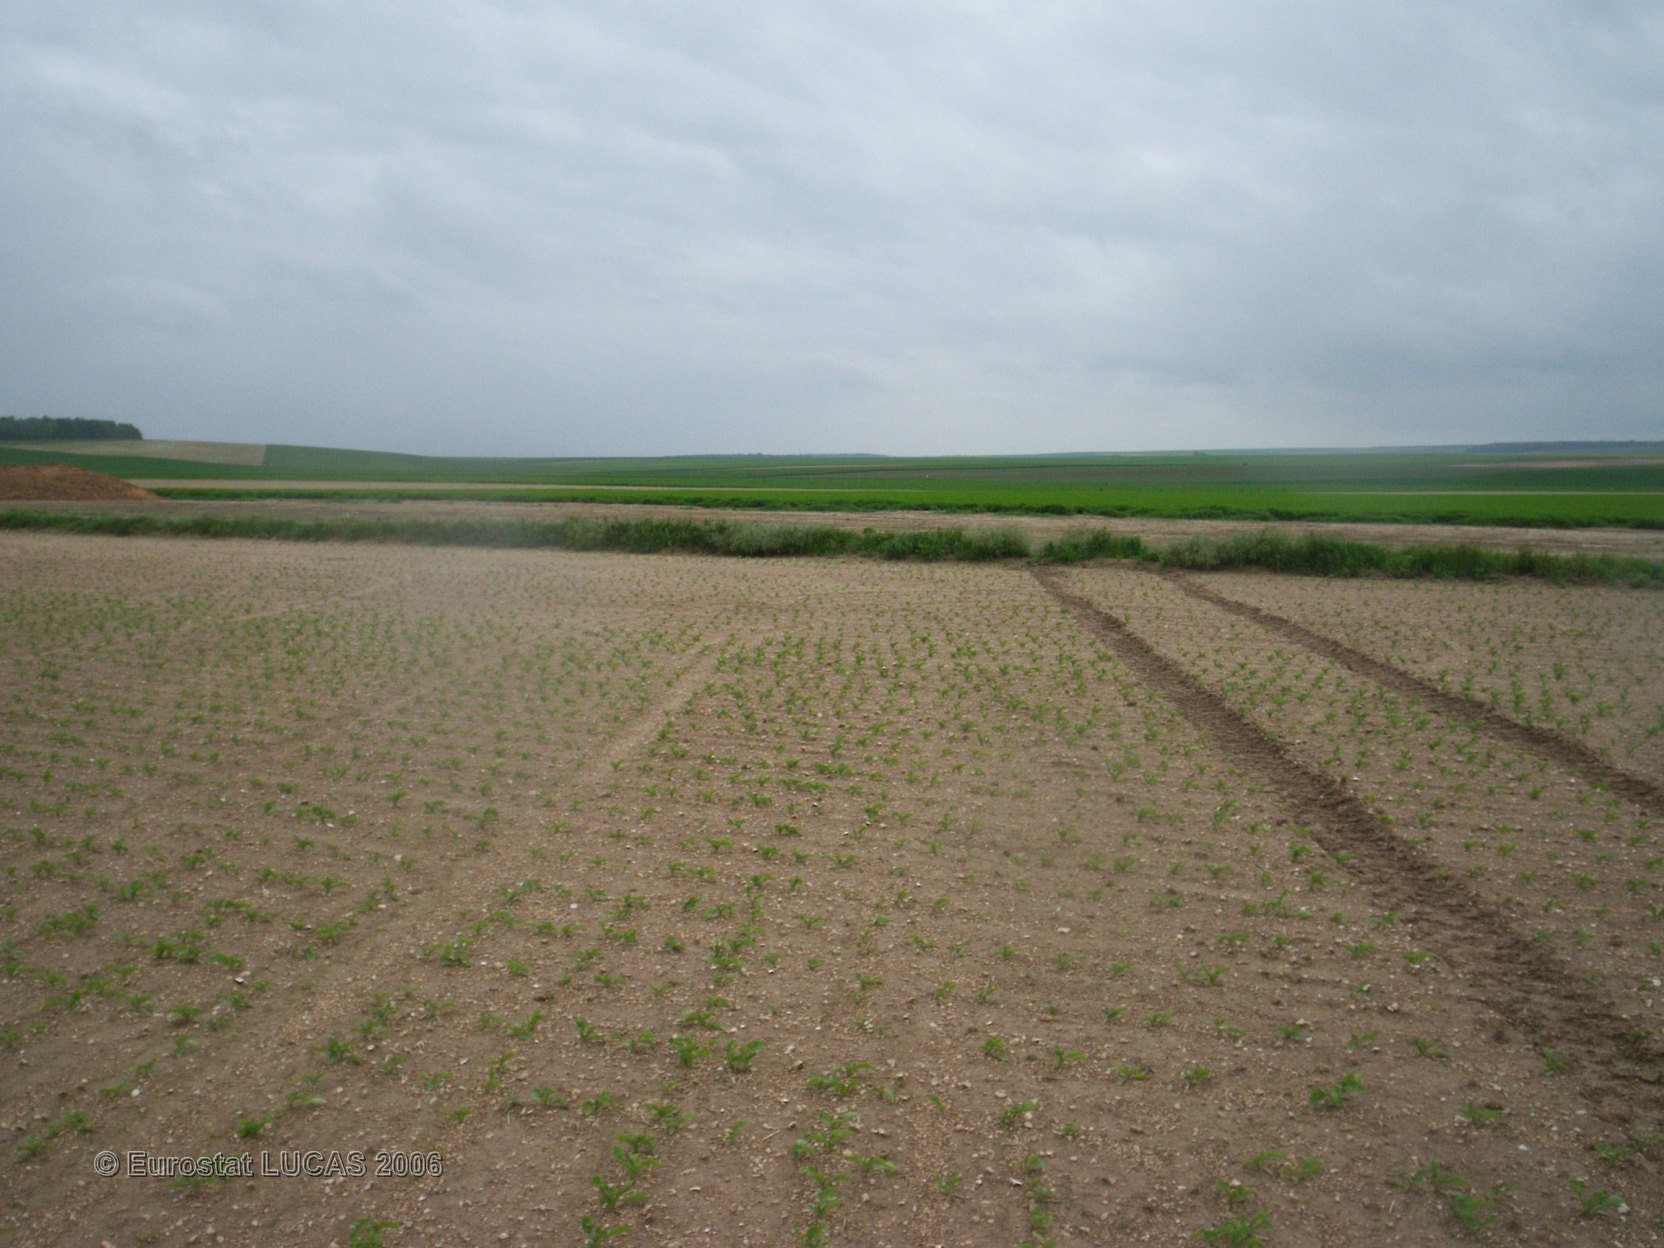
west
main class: Cropland
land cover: Sugar beet
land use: Agriculture (excluding fallow land and kitchen gardens)
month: May
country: FR
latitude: 49.3764
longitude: 4.3351
